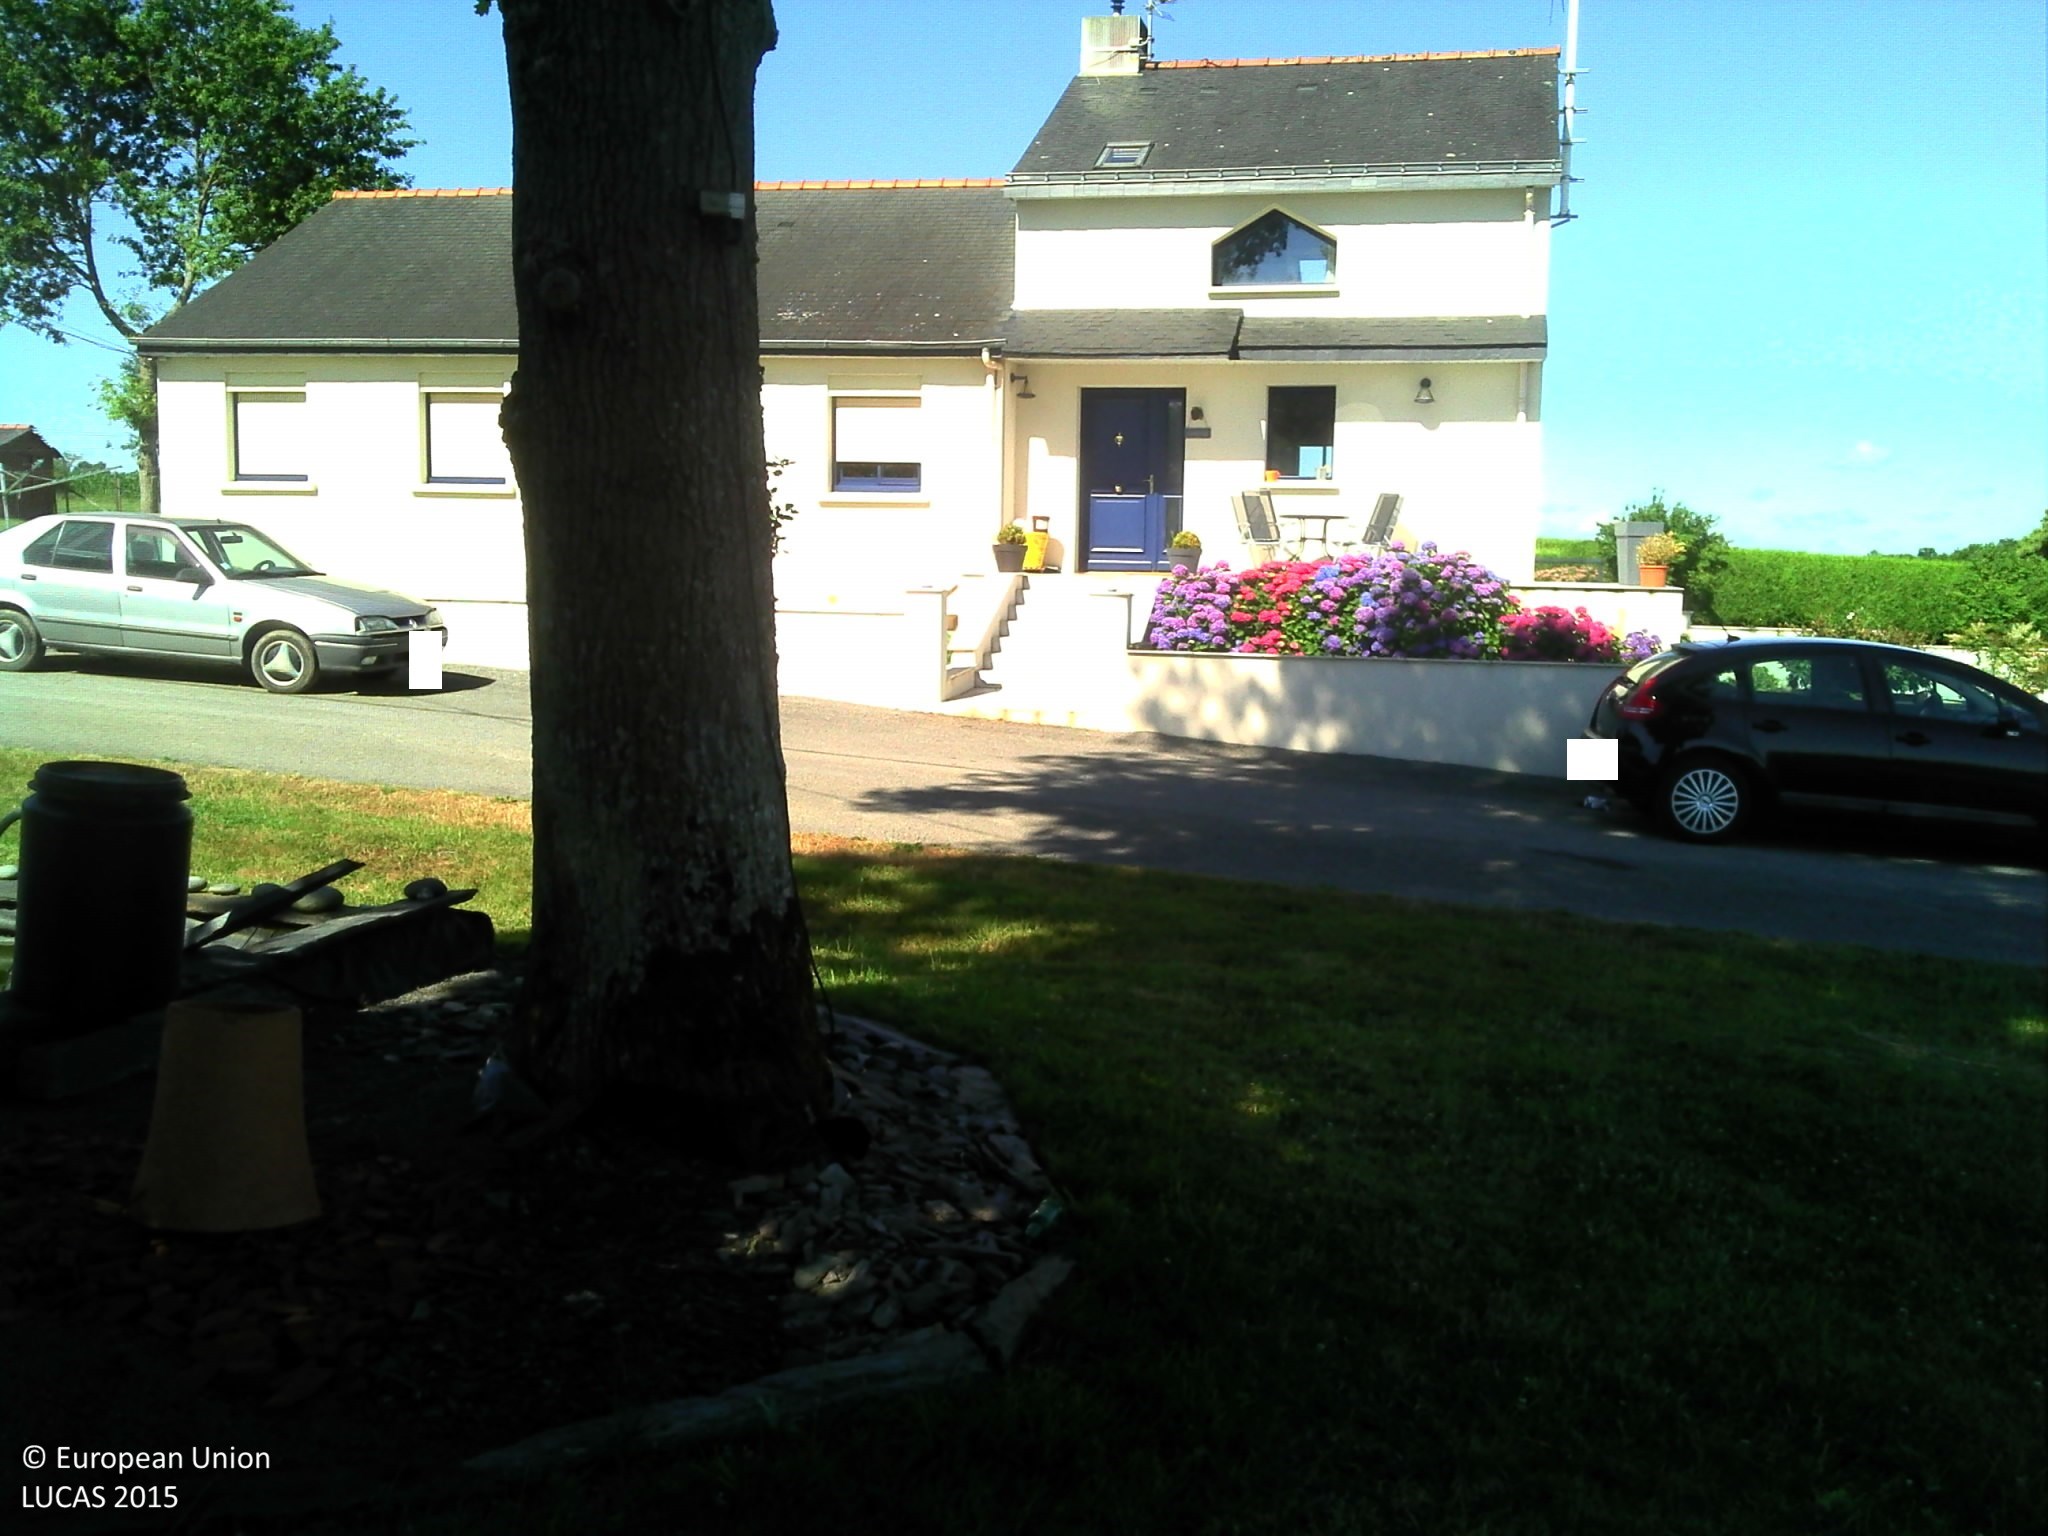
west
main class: Woodland
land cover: Broadleaved woodland
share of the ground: > 75 %
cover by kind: herbaceous plants 80 %, broadleaved forest trees 20 %
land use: Residential
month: July
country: FR
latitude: 47.7485
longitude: -1.9883
